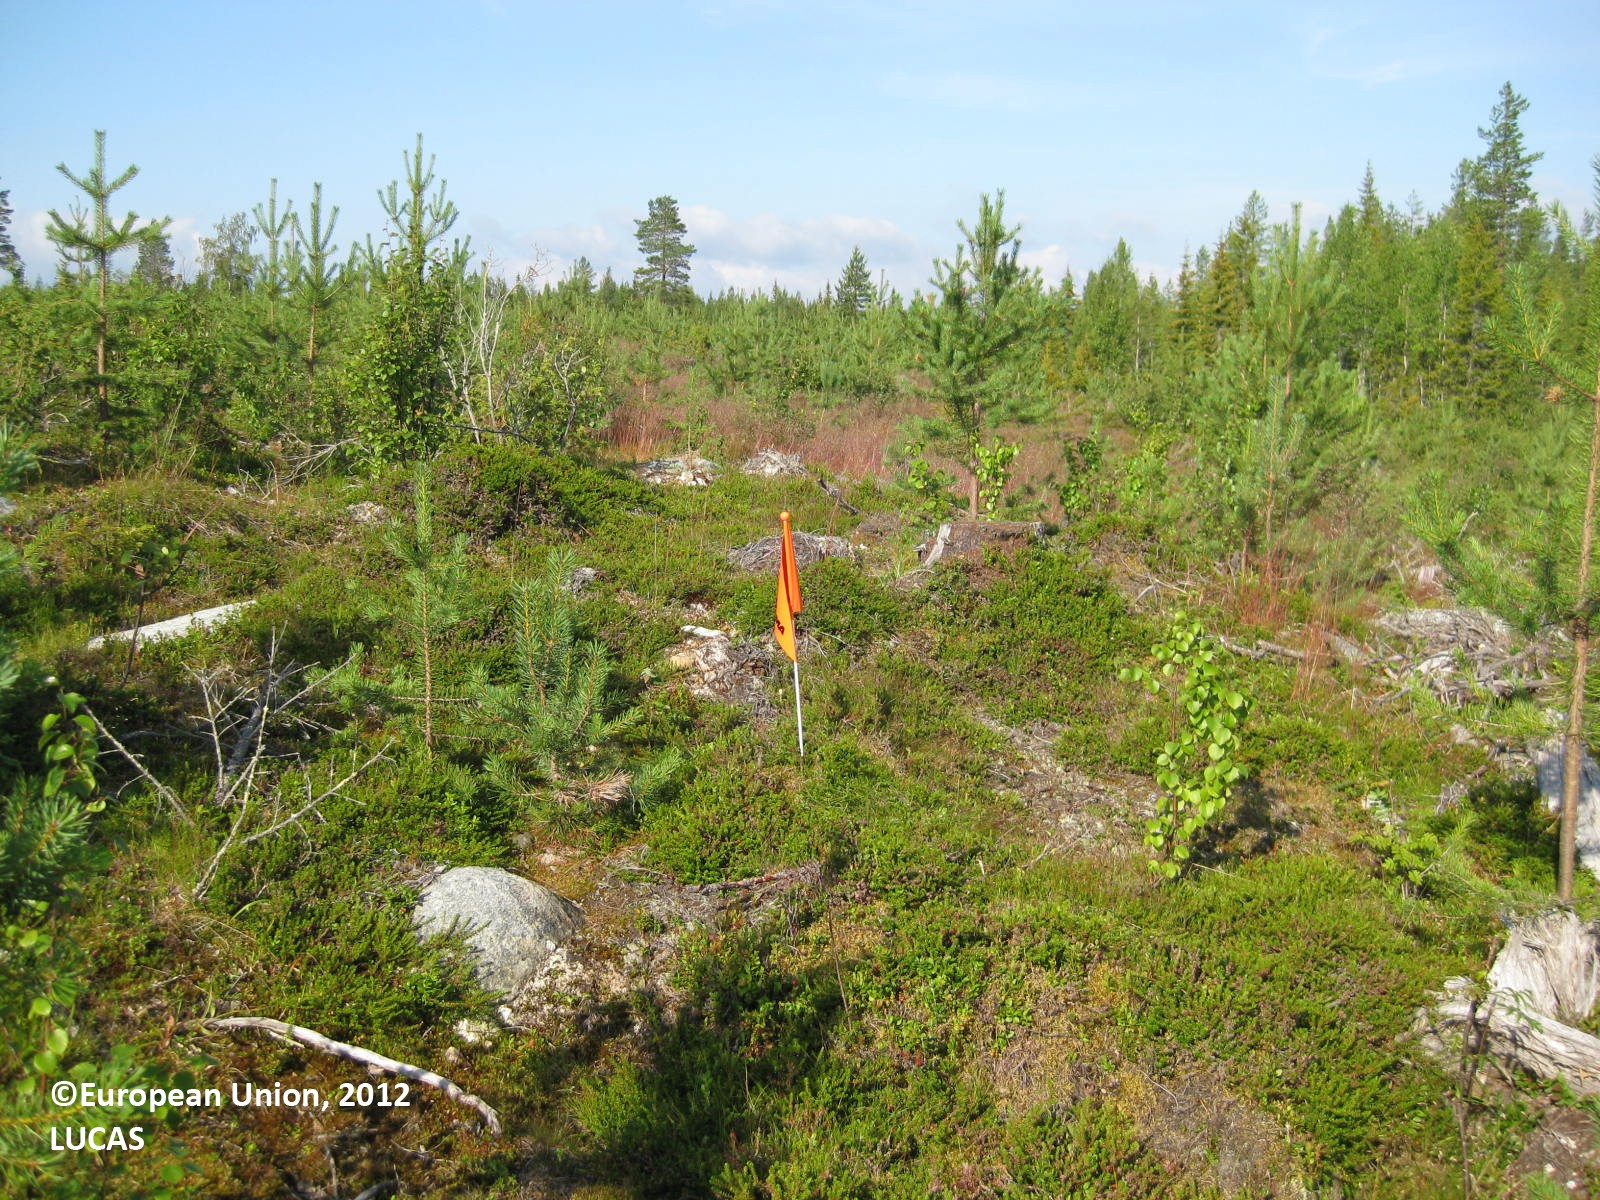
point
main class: Woodland
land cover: Pine dominated mixed woodland
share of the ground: 25 - 50 %
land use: Forestry
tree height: < 5 m
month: July
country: FI
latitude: 65.8293
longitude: 28.5659
